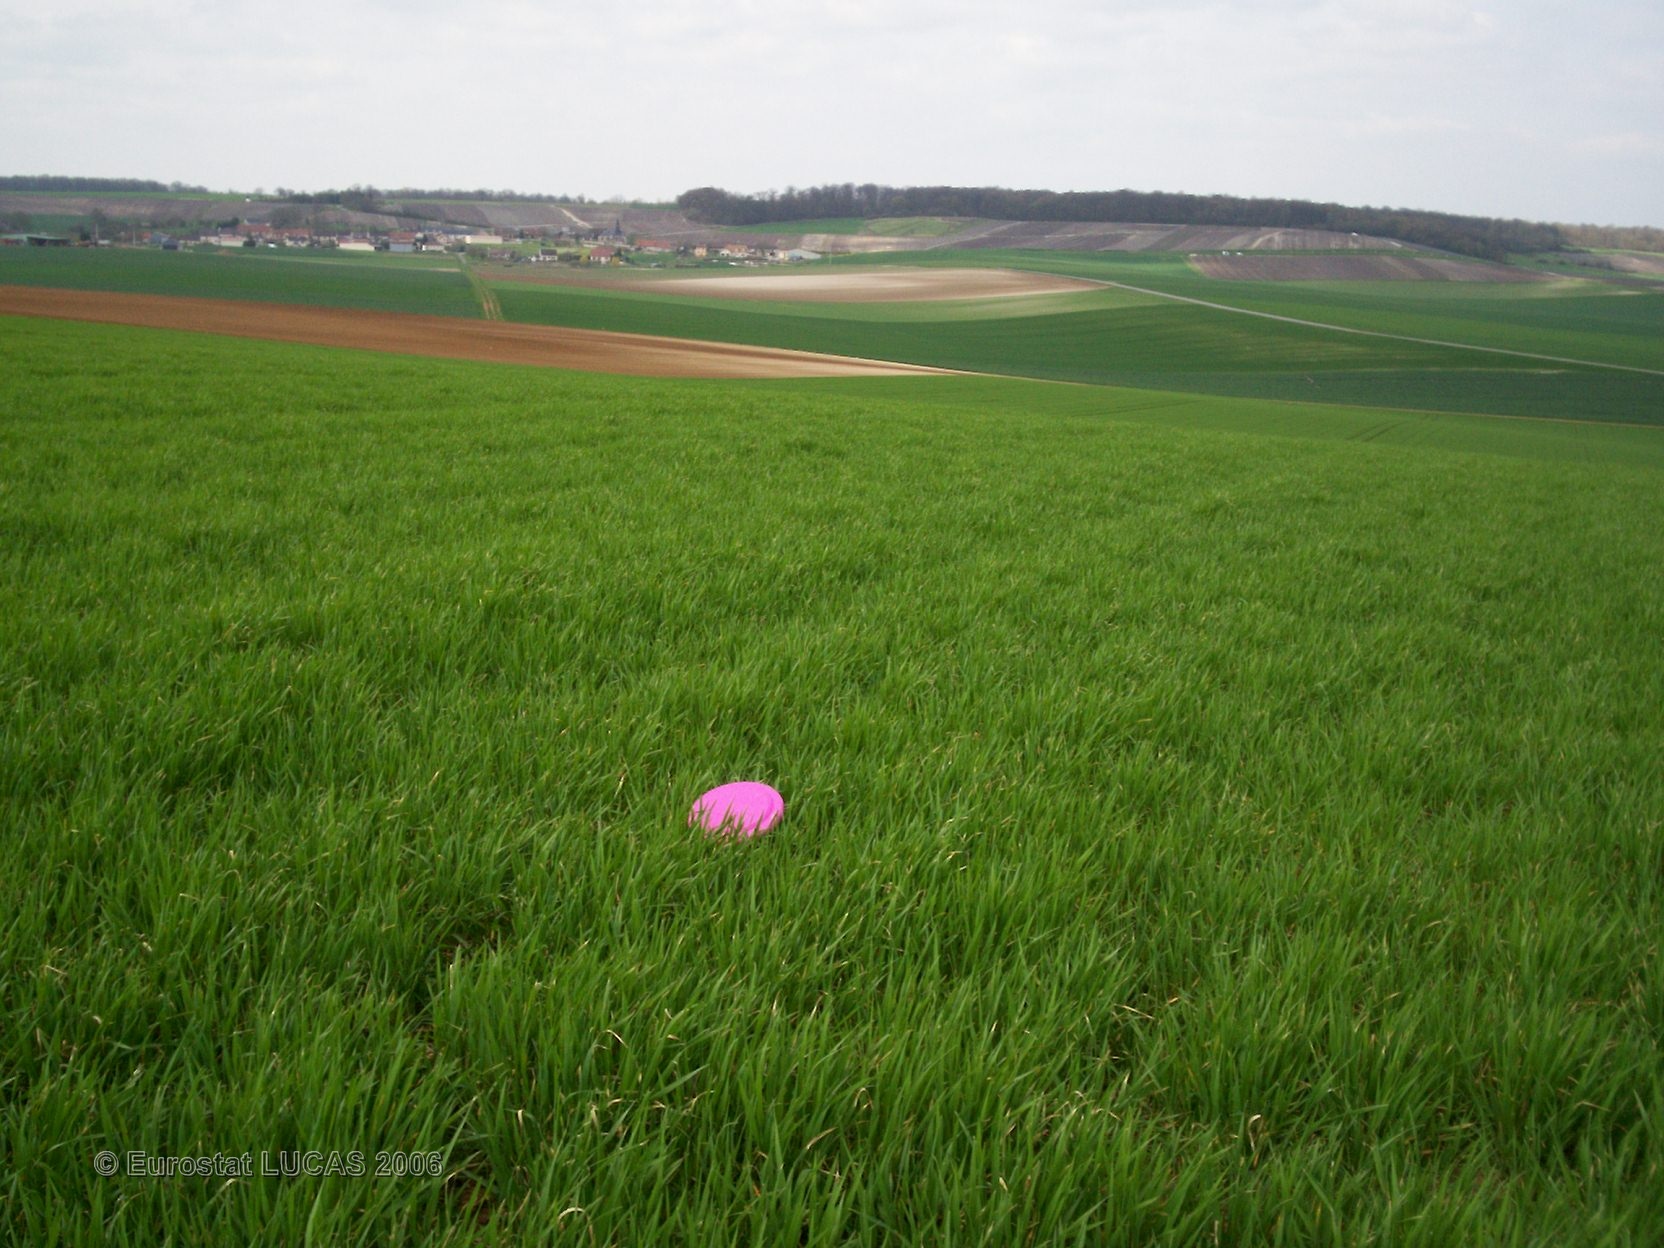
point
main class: Cropland
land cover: Barley
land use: Agriculture (excluding fallow land and kitchen gardens)
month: April
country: FR
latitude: 48.8860
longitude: 3.9262
